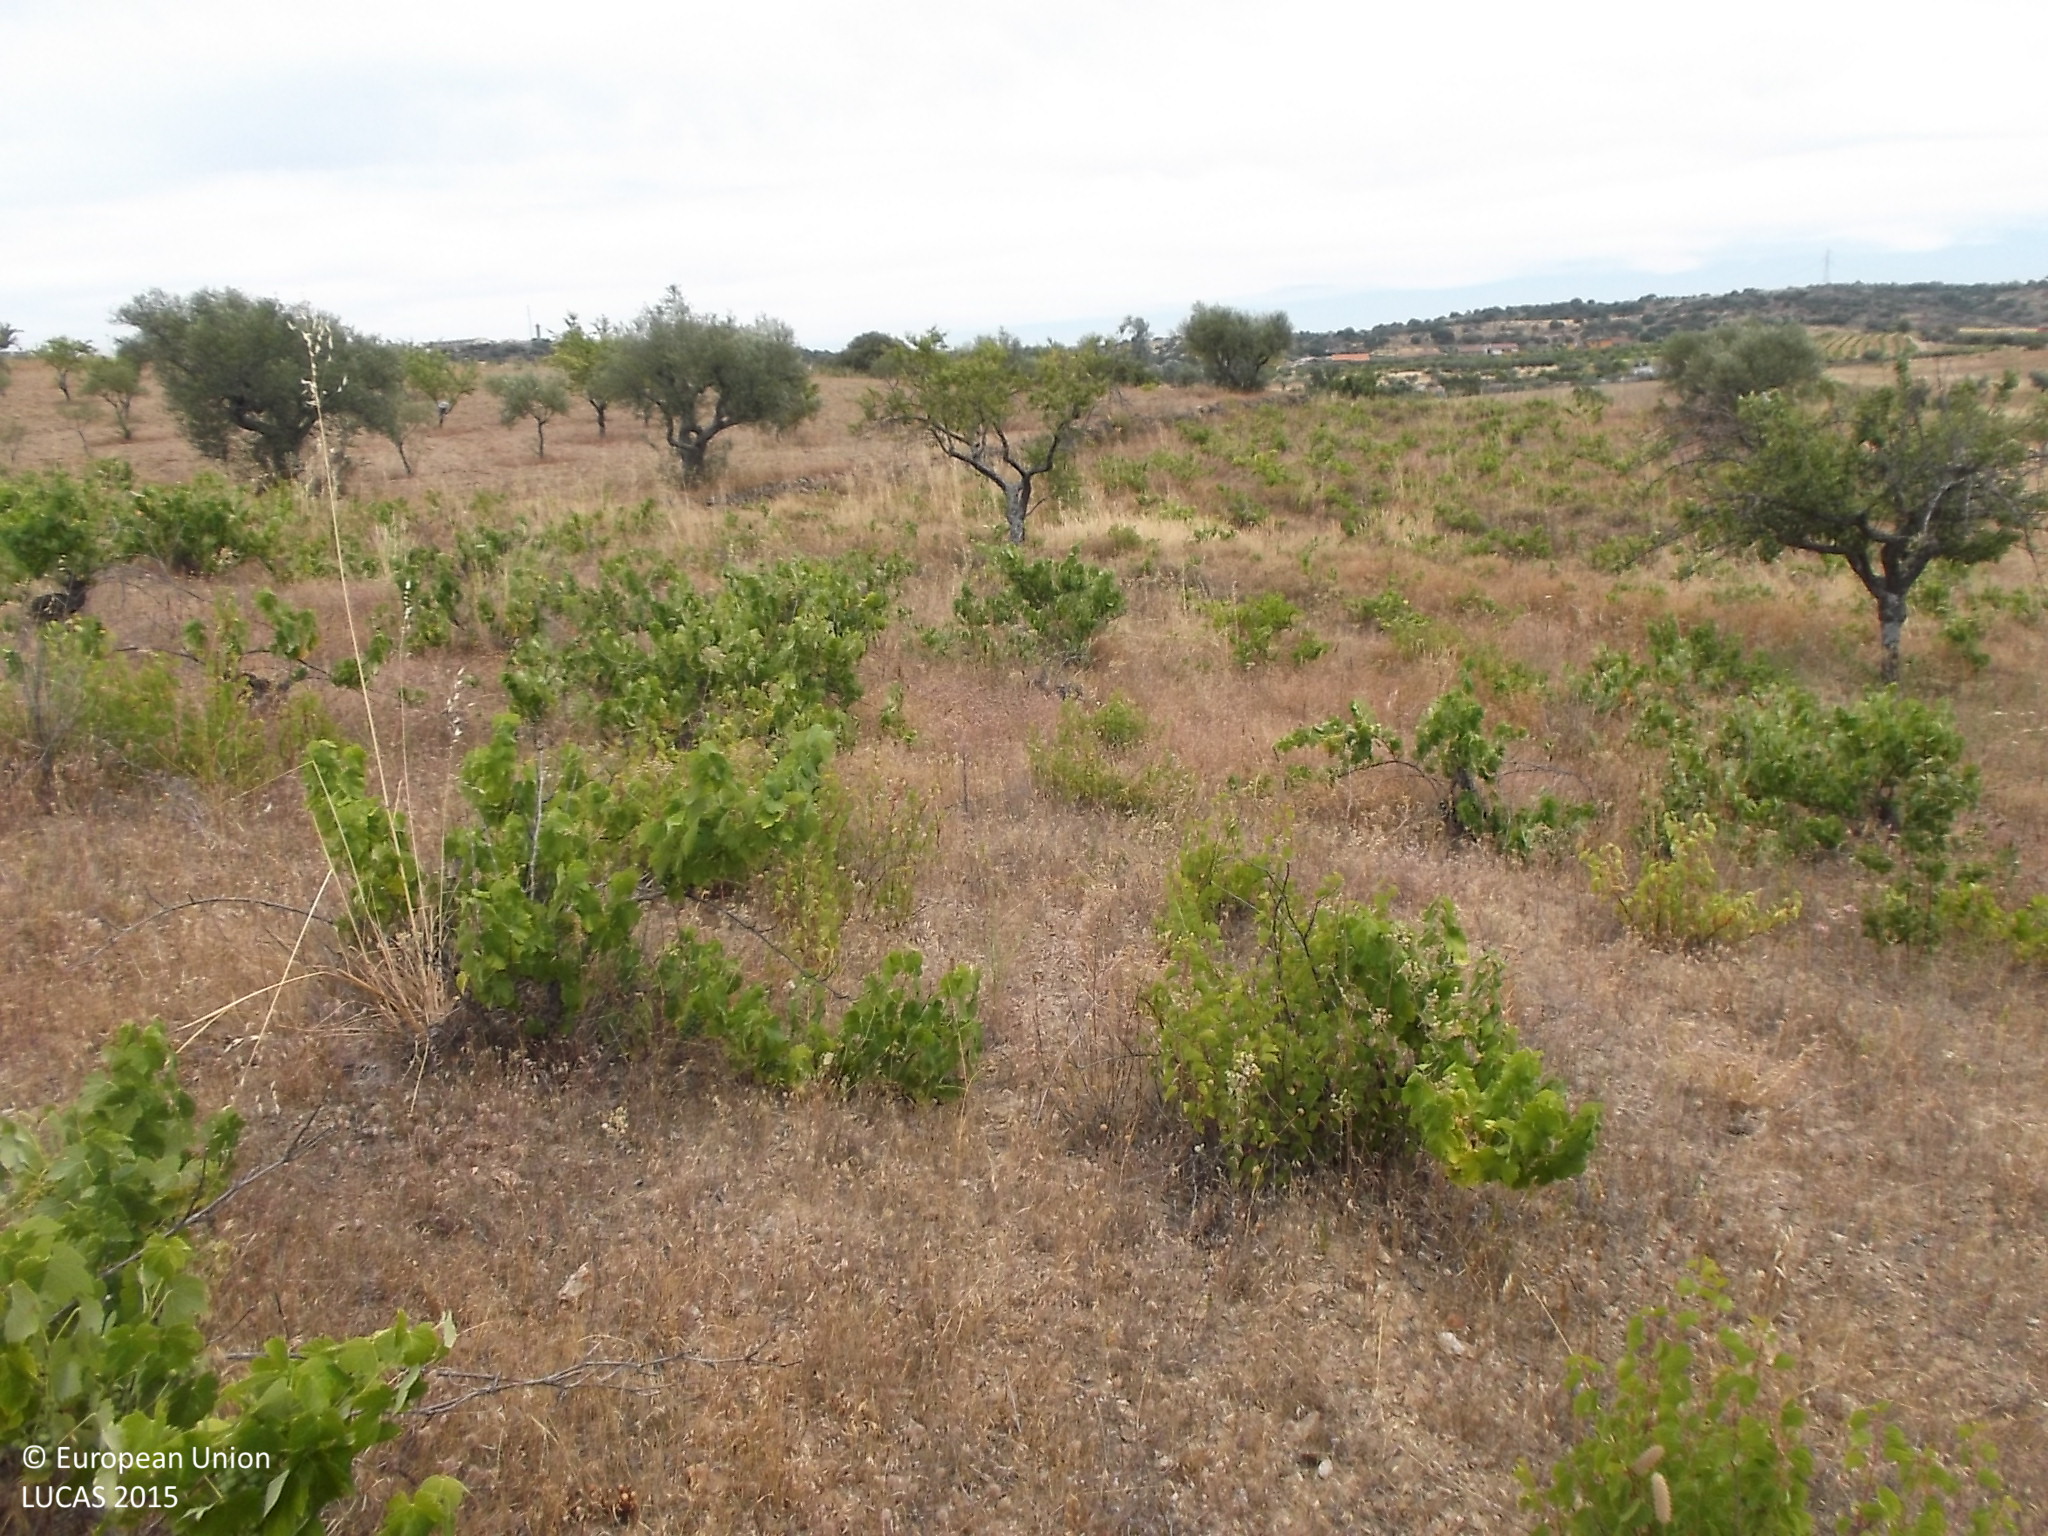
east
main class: Cropland
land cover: Vineyards
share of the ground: 10 - 25 %
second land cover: Spontaneously vegetated surfaces
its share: > 75 %
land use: Agriculture (excluding fallow land and kitchen gardens)
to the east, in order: Vineyards; Spontaneously vegetated surfaces; Dry stone walls; Grass margins; Tracks; Grass margins; Dry stone walls; Olive groves; Vineyards; Tomatoes; Other fresh vegetables; Grass margins; Other bare soil; Grass margins; Groves; Dry stone walls; Rivers and streams; Dry stone walls; Groves; Grassland without tree/shrub cover
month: July
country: ES
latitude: 41.3064
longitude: -6.4012
